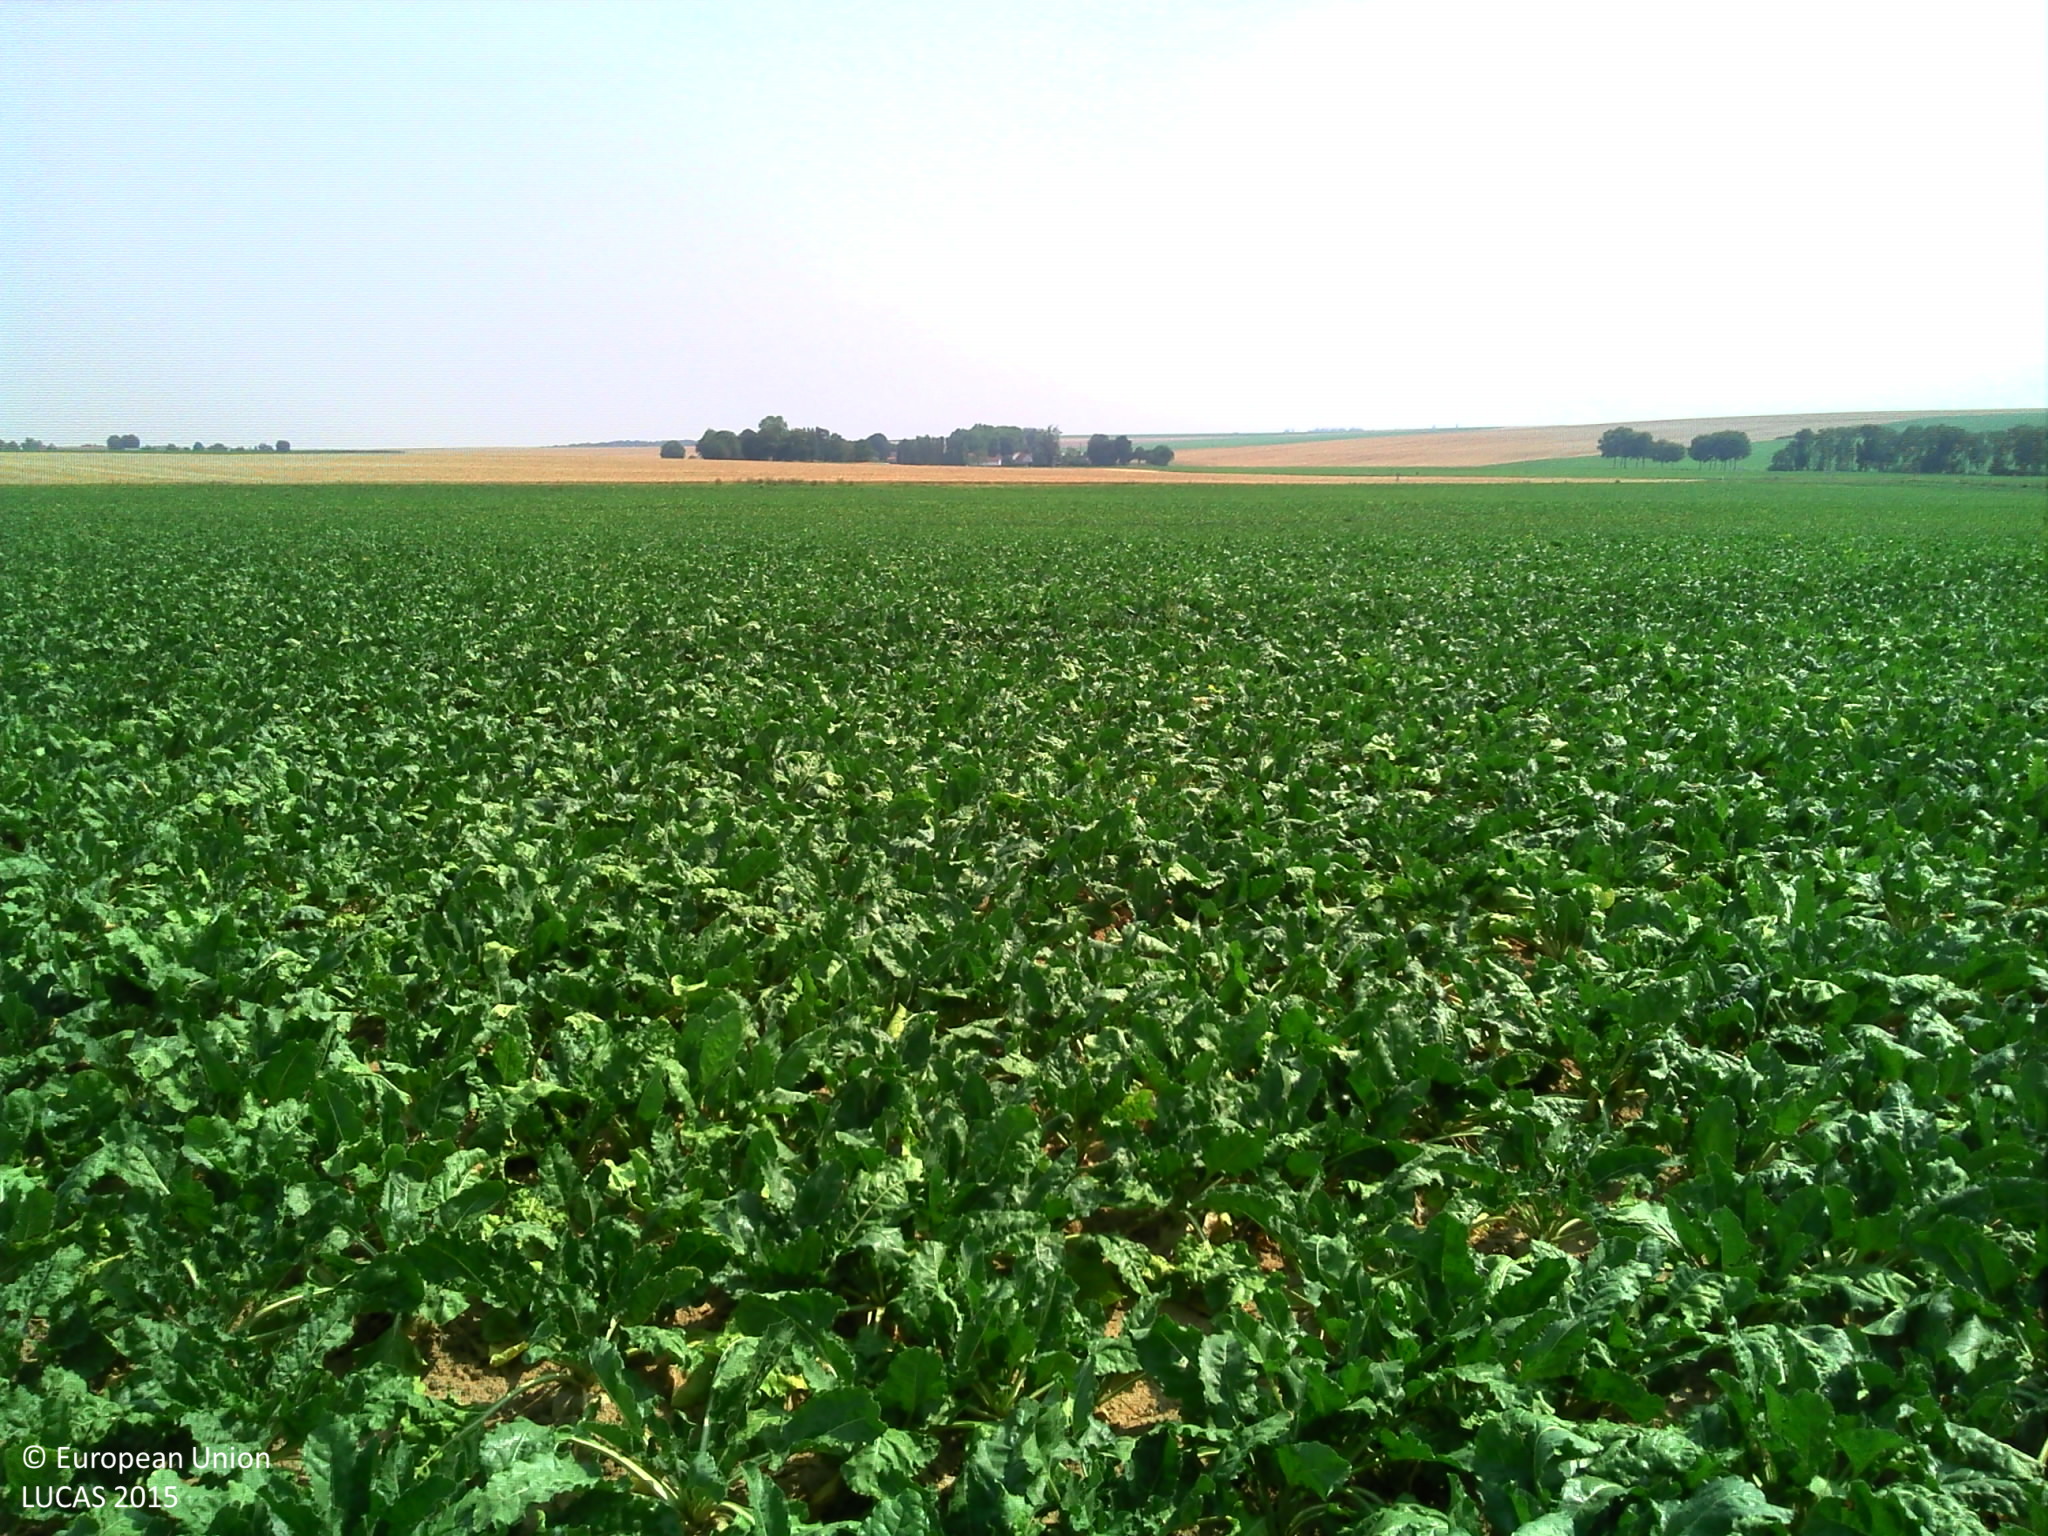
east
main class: Cropland
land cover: Sugar beet
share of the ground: > 75 %
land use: Agriculture (excluding fallow land and kitchen gardens)
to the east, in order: Sugar beet
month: August
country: FR
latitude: 49.0628
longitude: 2.9424
